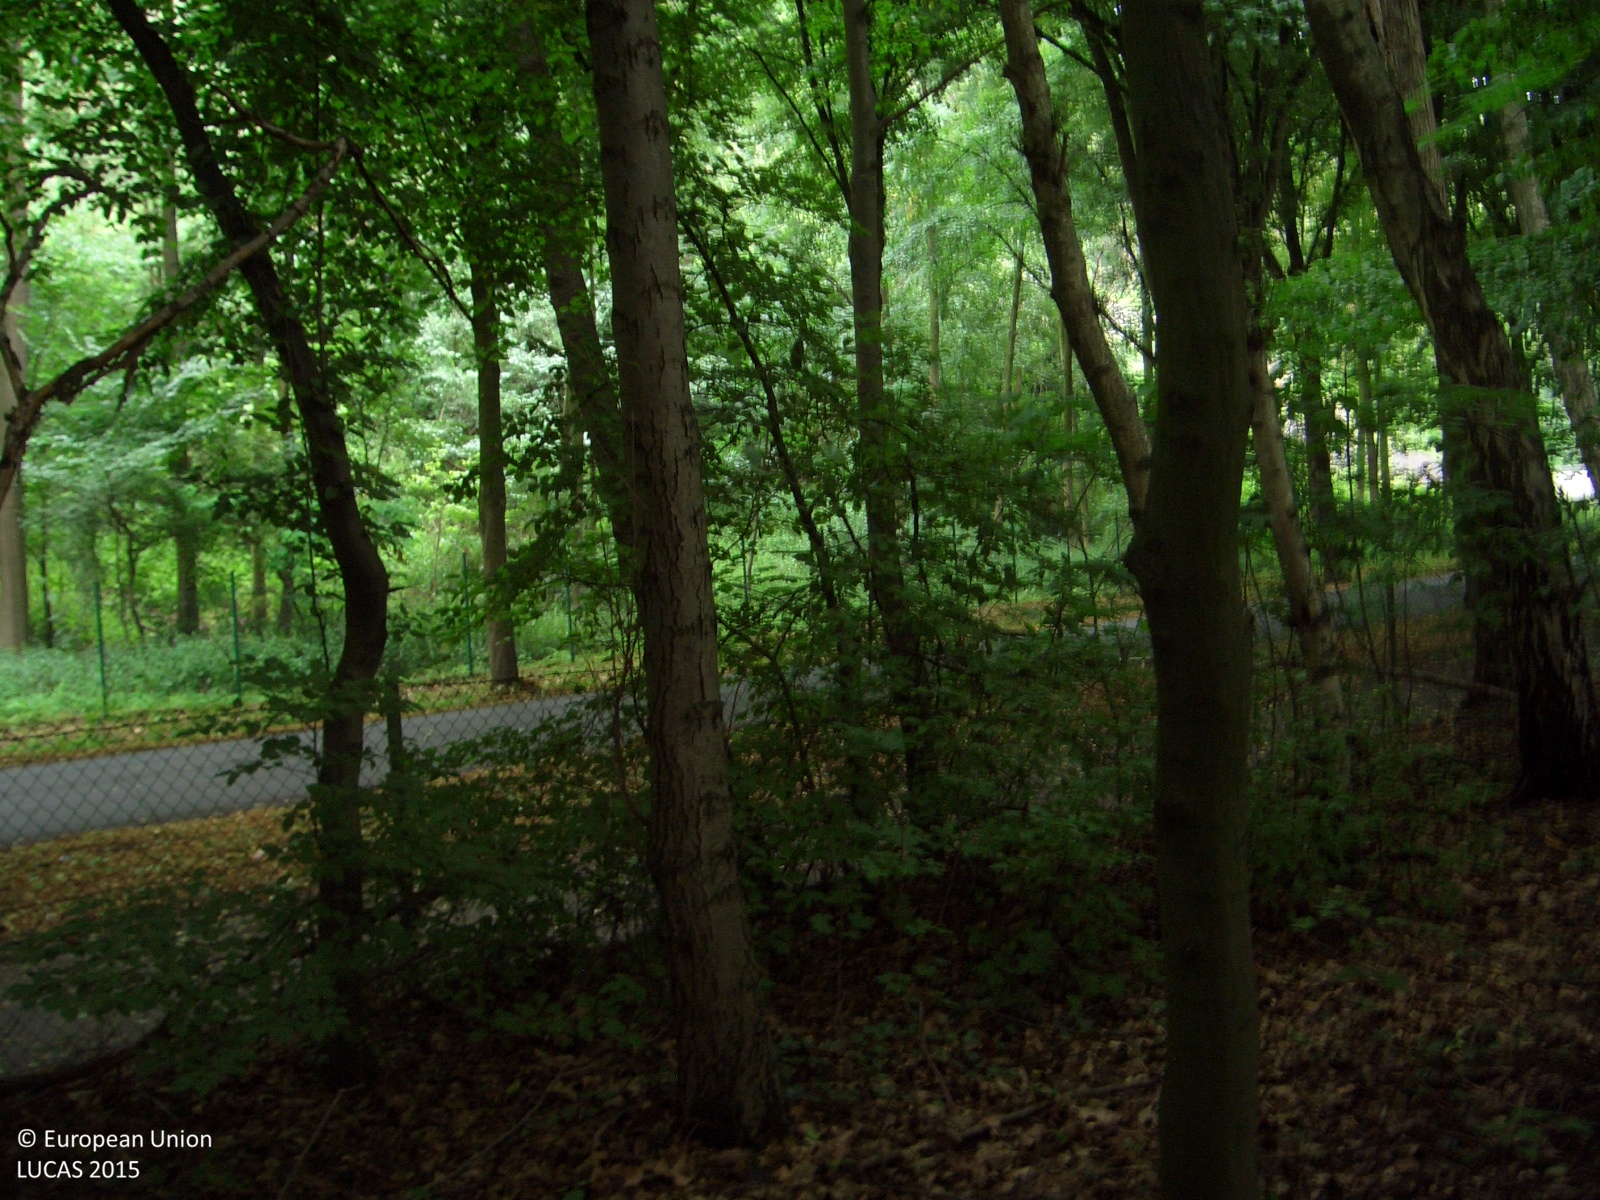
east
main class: Woodland
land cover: Broadleaved woodland
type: mesophytic deciduous forest
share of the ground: > 75 %
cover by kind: broadleaved forest trees 100 %
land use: Energy production
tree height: > 5 m
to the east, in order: Broadleaved woodland; Fences; Paved roads, cycling and walking lanes; Lines of trees; Paved roads, cycling and walking lanes; Lines of trees; Fences; Broadleaved woodland
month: July
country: DE
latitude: 51.6024
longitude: 7.0114
